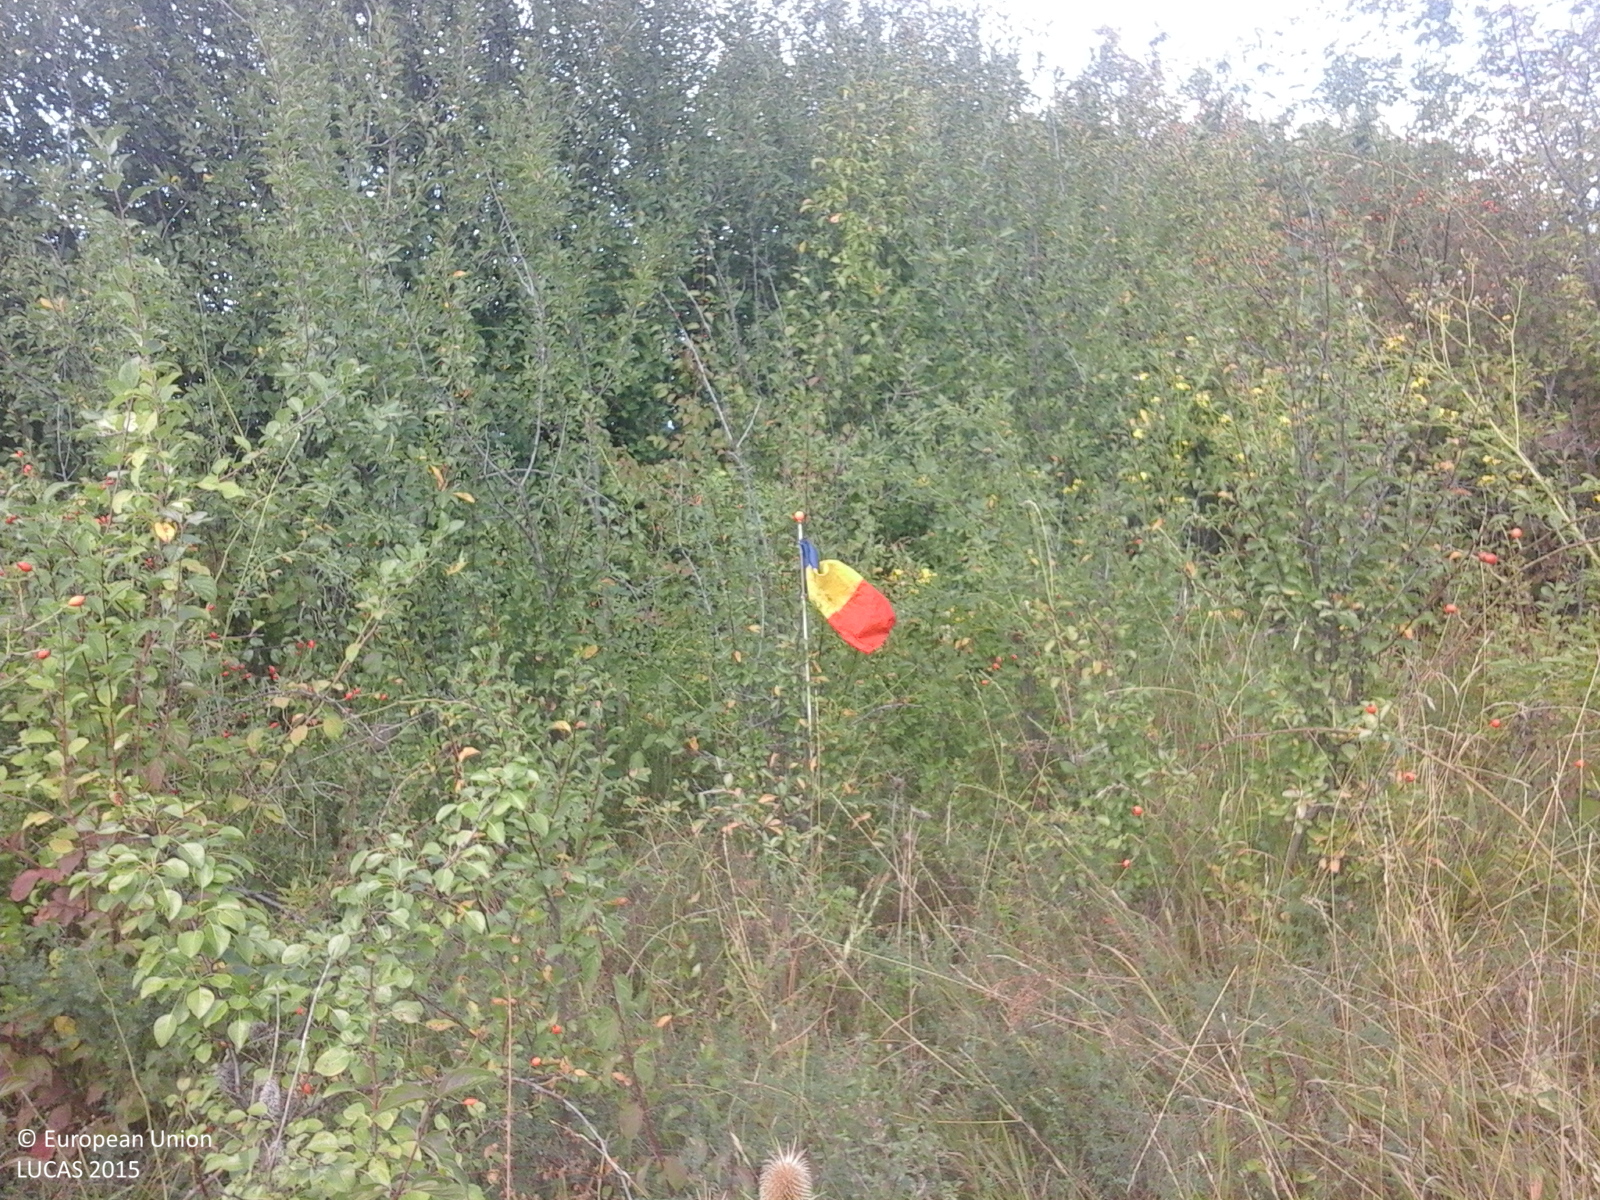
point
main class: Shrubland
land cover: Shrubland without tree cover
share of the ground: > 75 %
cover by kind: shrubs 100 %
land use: Fallow land
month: September
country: RO
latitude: 47.4665
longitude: 23.4591
